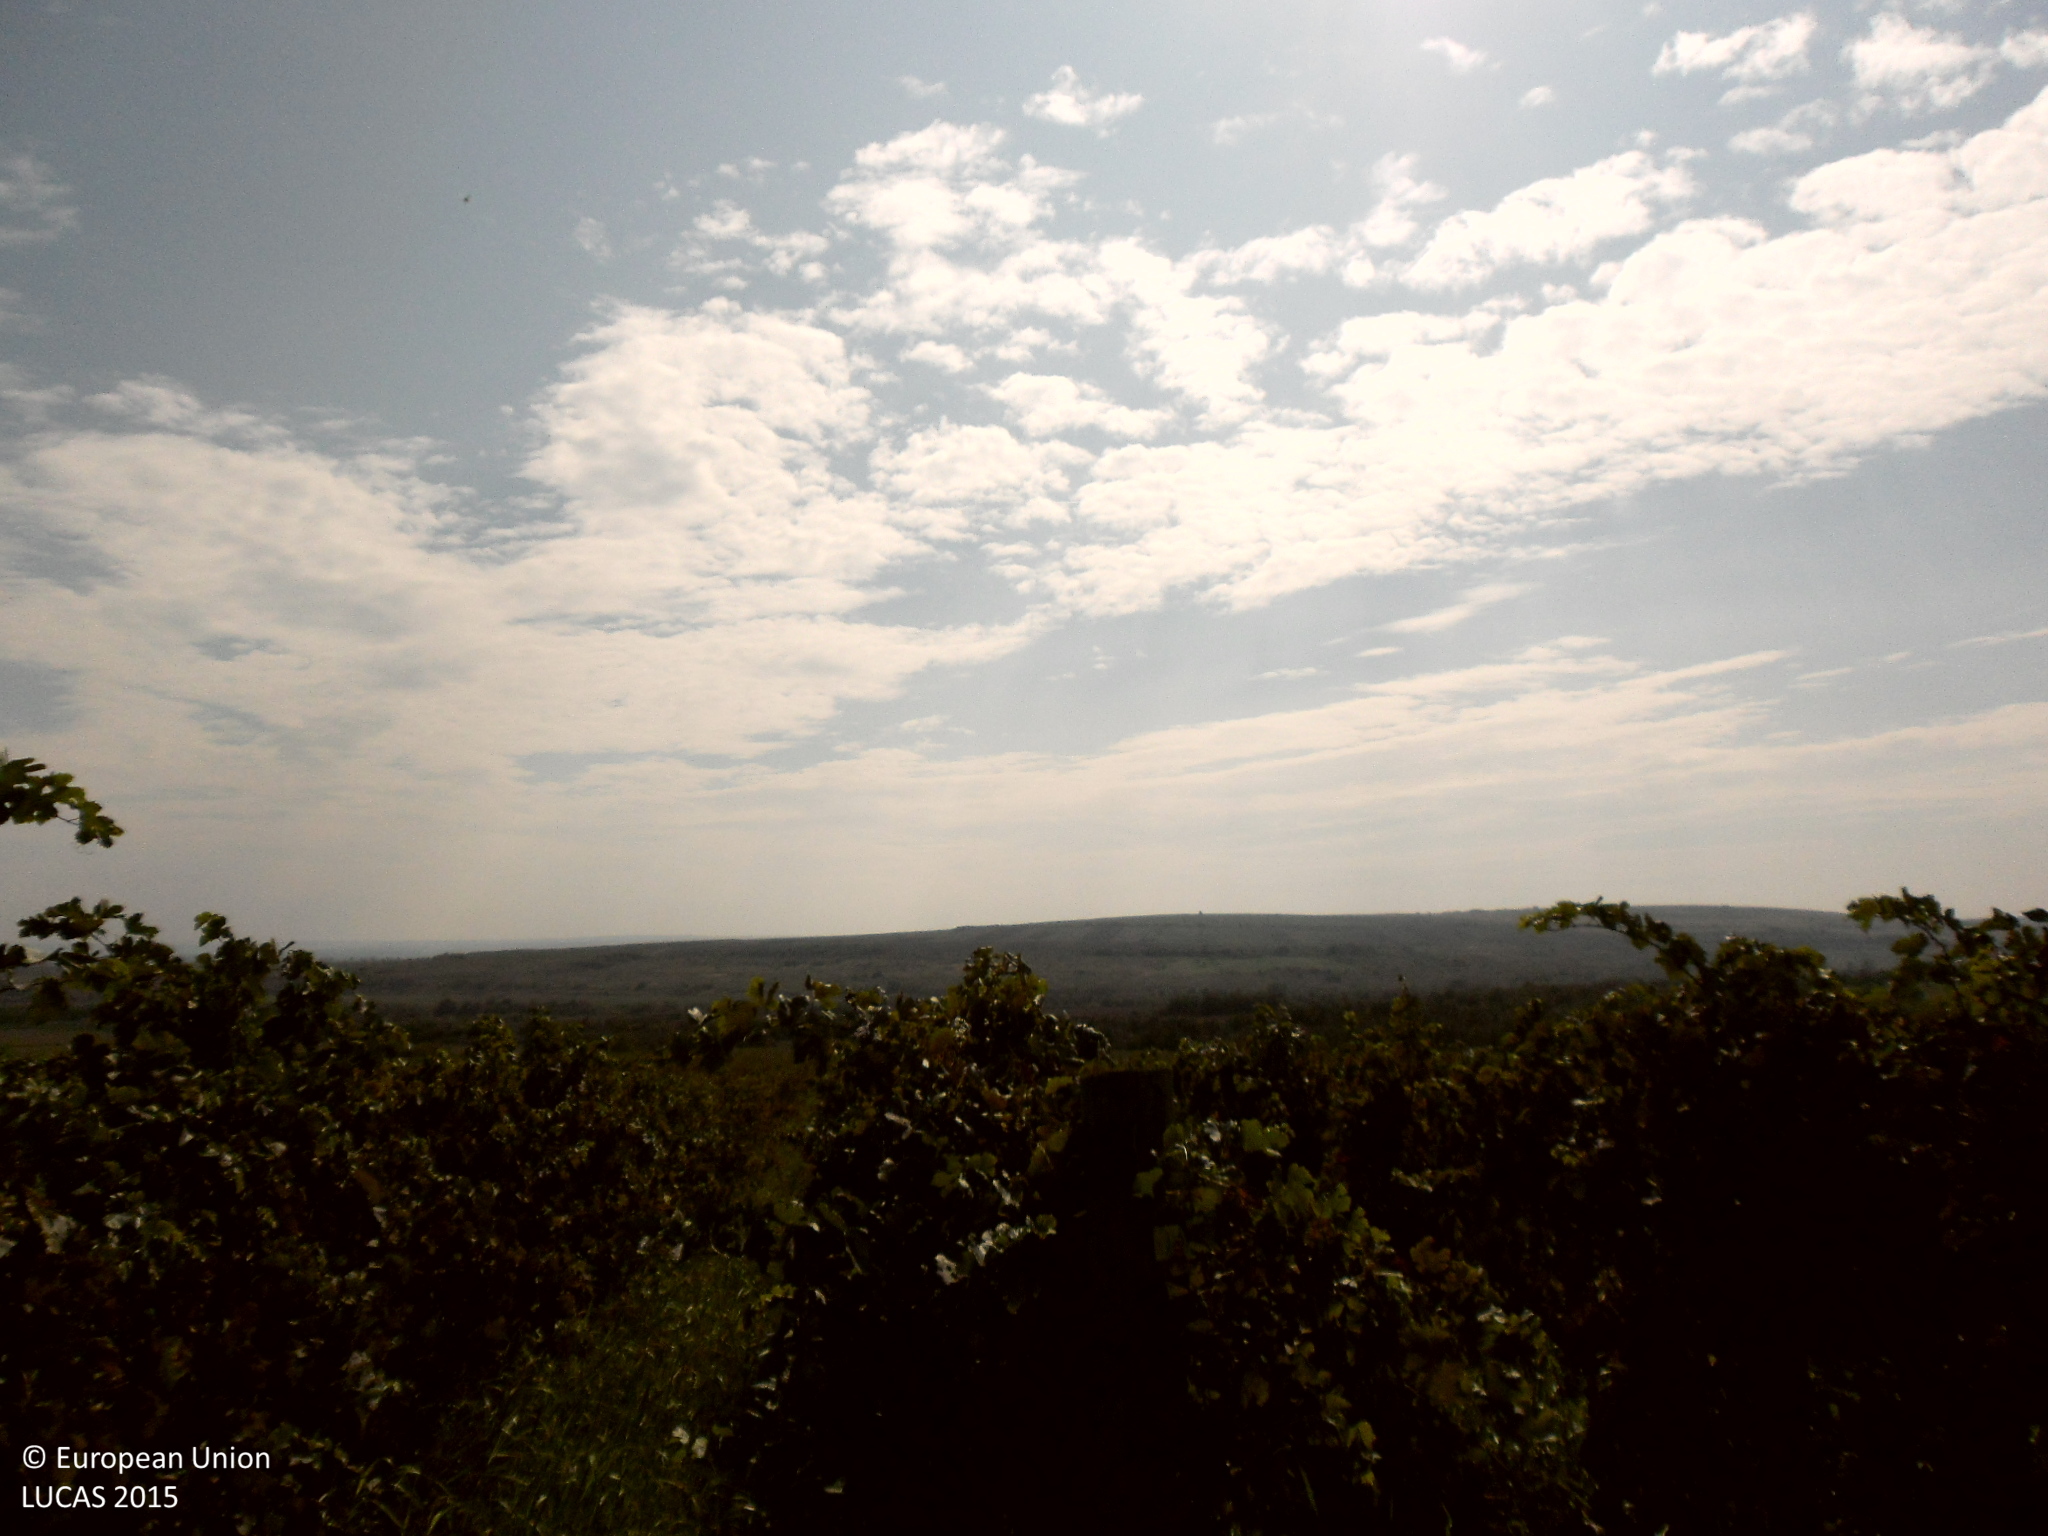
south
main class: Artificial land
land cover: Non built-up linear features
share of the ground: > 75 %
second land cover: Grassland without tree/shrub cover
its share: 25 - 50 %
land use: Road transport
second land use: Agriculture (excluding fallow land and kitchen gardens)
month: October
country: BG
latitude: 44.0135
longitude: 22.7740
